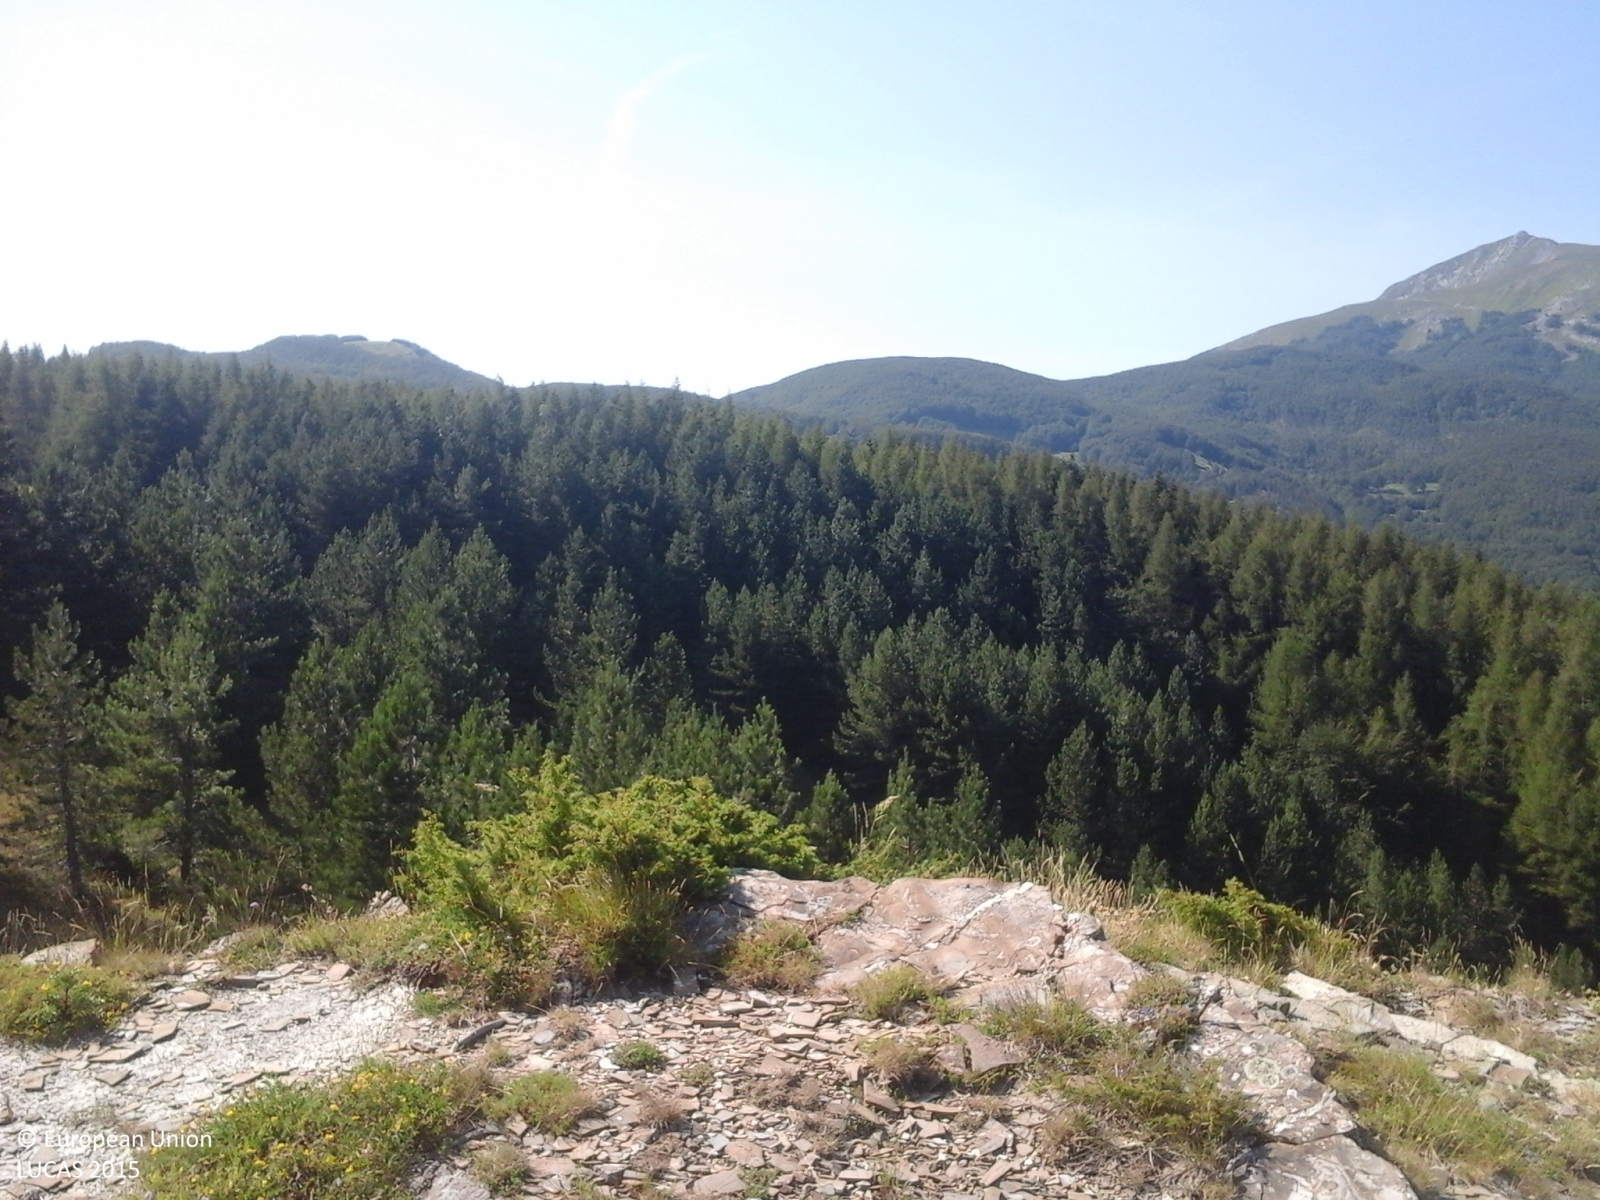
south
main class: Woodland
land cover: Pine dominated coniferous woodland
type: alpine coniferous forest
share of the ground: 50 - 75 %
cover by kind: coniferous forest trees 75 %, herbaceous plants 15 %, broadleaved forest trees 5 %, shrubs 5 %
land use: Semi-natural and natural areas not in use
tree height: > 5 m
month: July
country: IT
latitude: 44.3684
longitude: 10.2128
